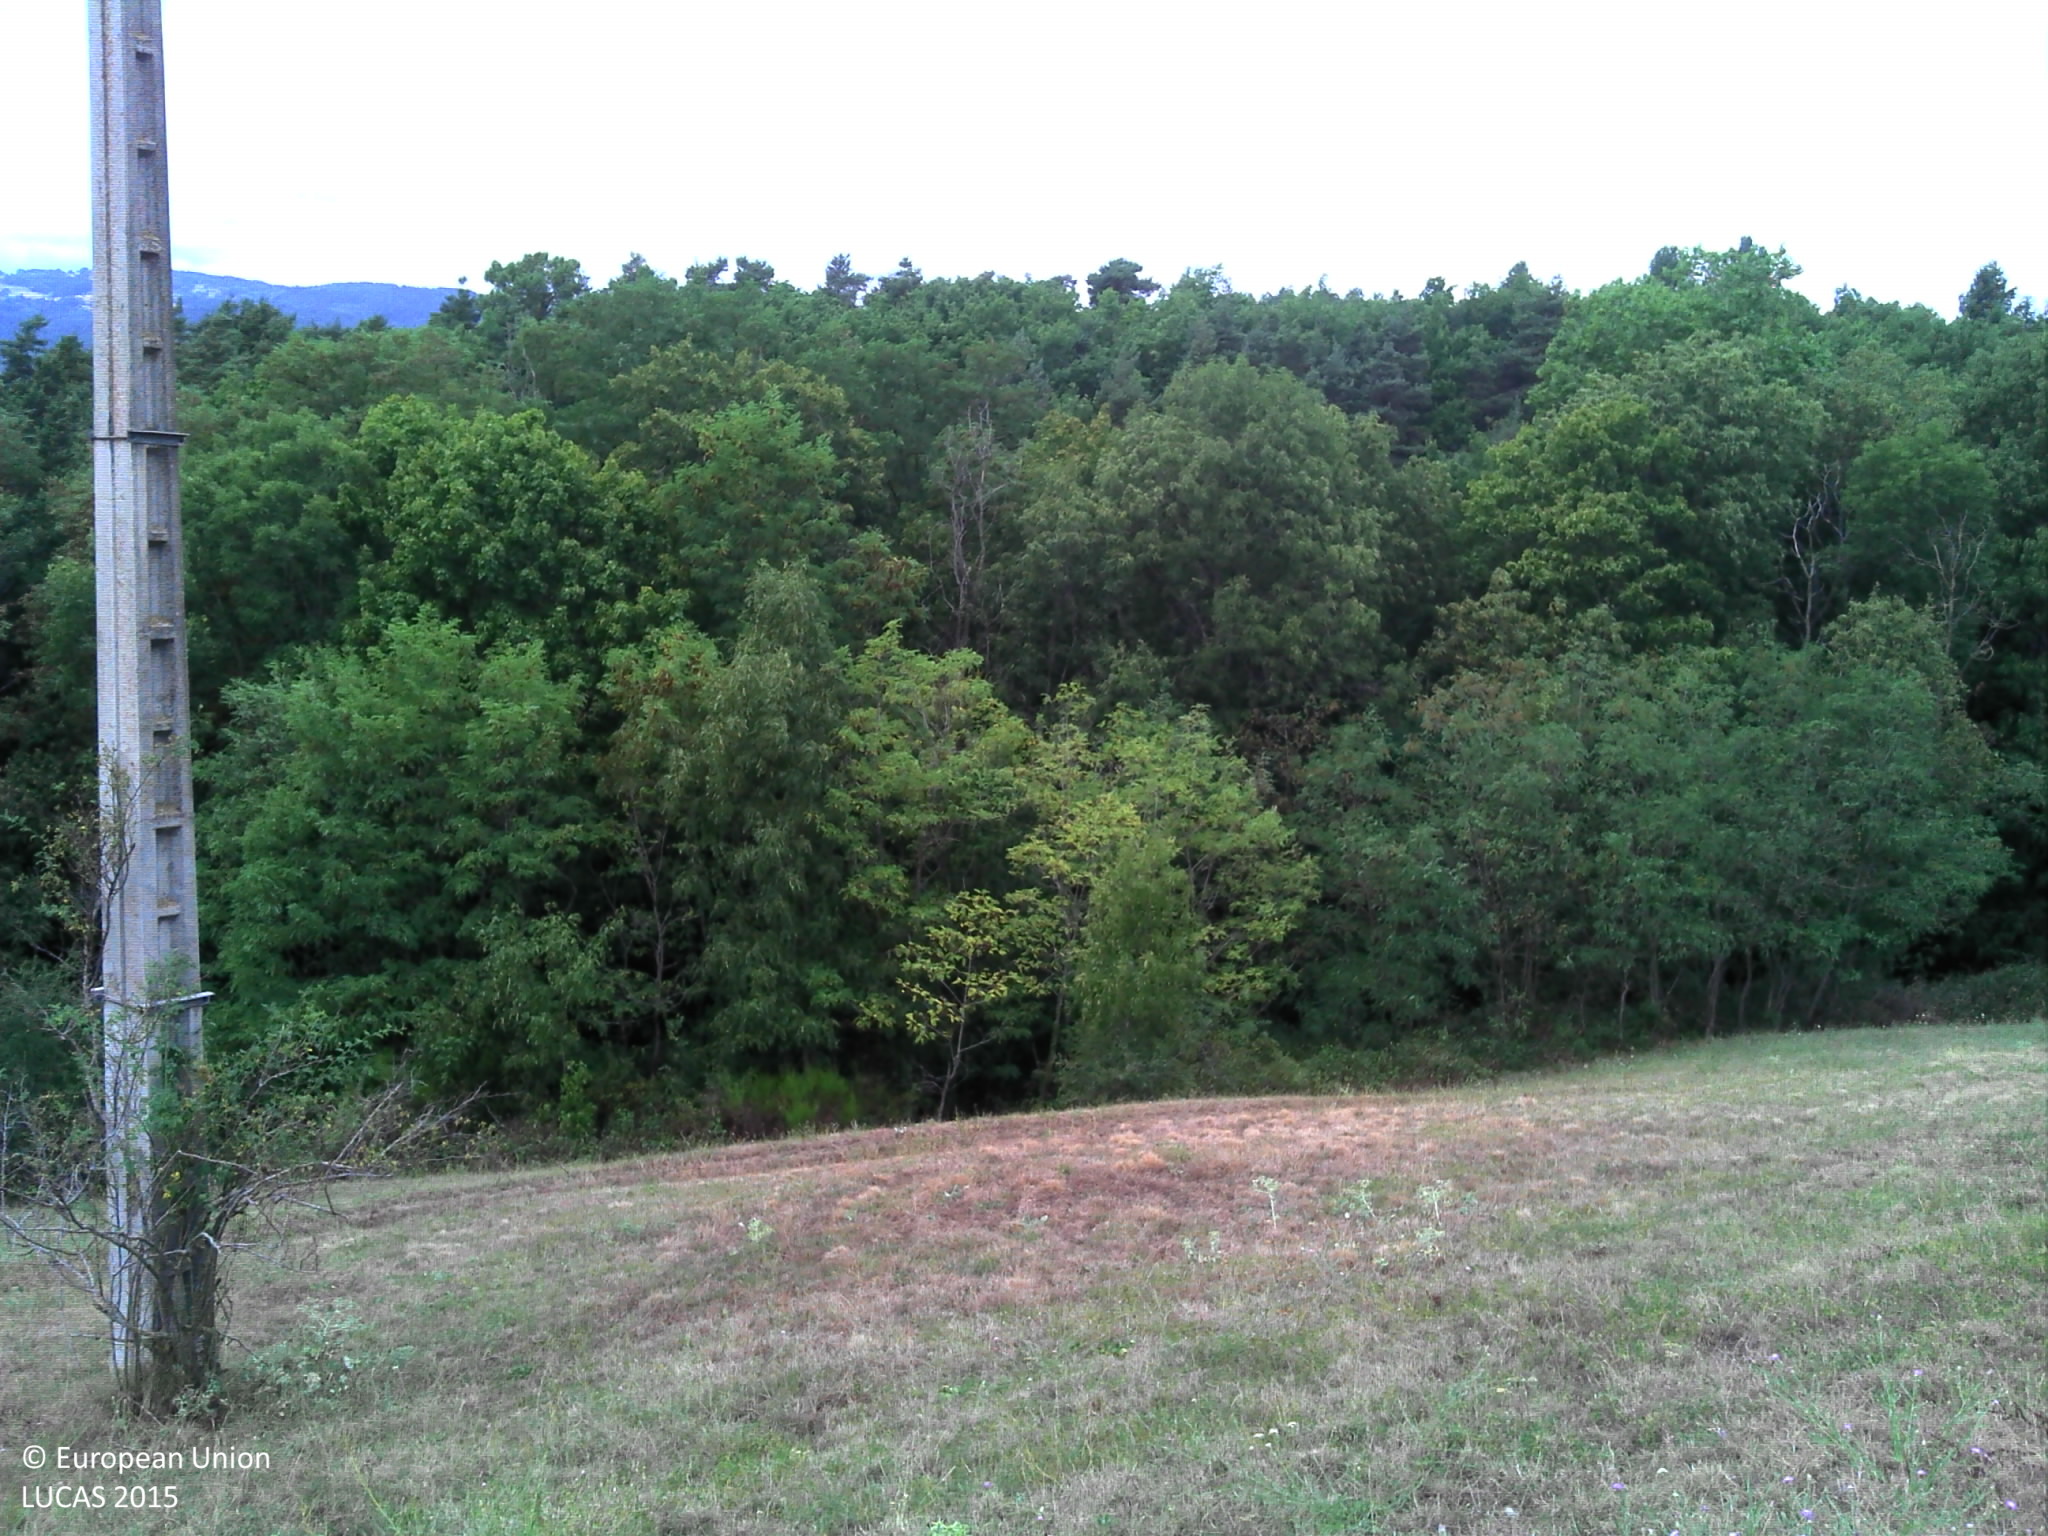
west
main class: Grassland
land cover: Grassland without tree/shrub cover
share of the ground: > 75 %
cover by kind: herbaceous plants 85 %, unconsolidated bare surface 15 %
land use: Agriculture (excluding fallow land and kitchen gardens)
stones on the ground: 10 - 25 %
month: August
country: FR
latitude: 45.2945
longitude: 4.6107
